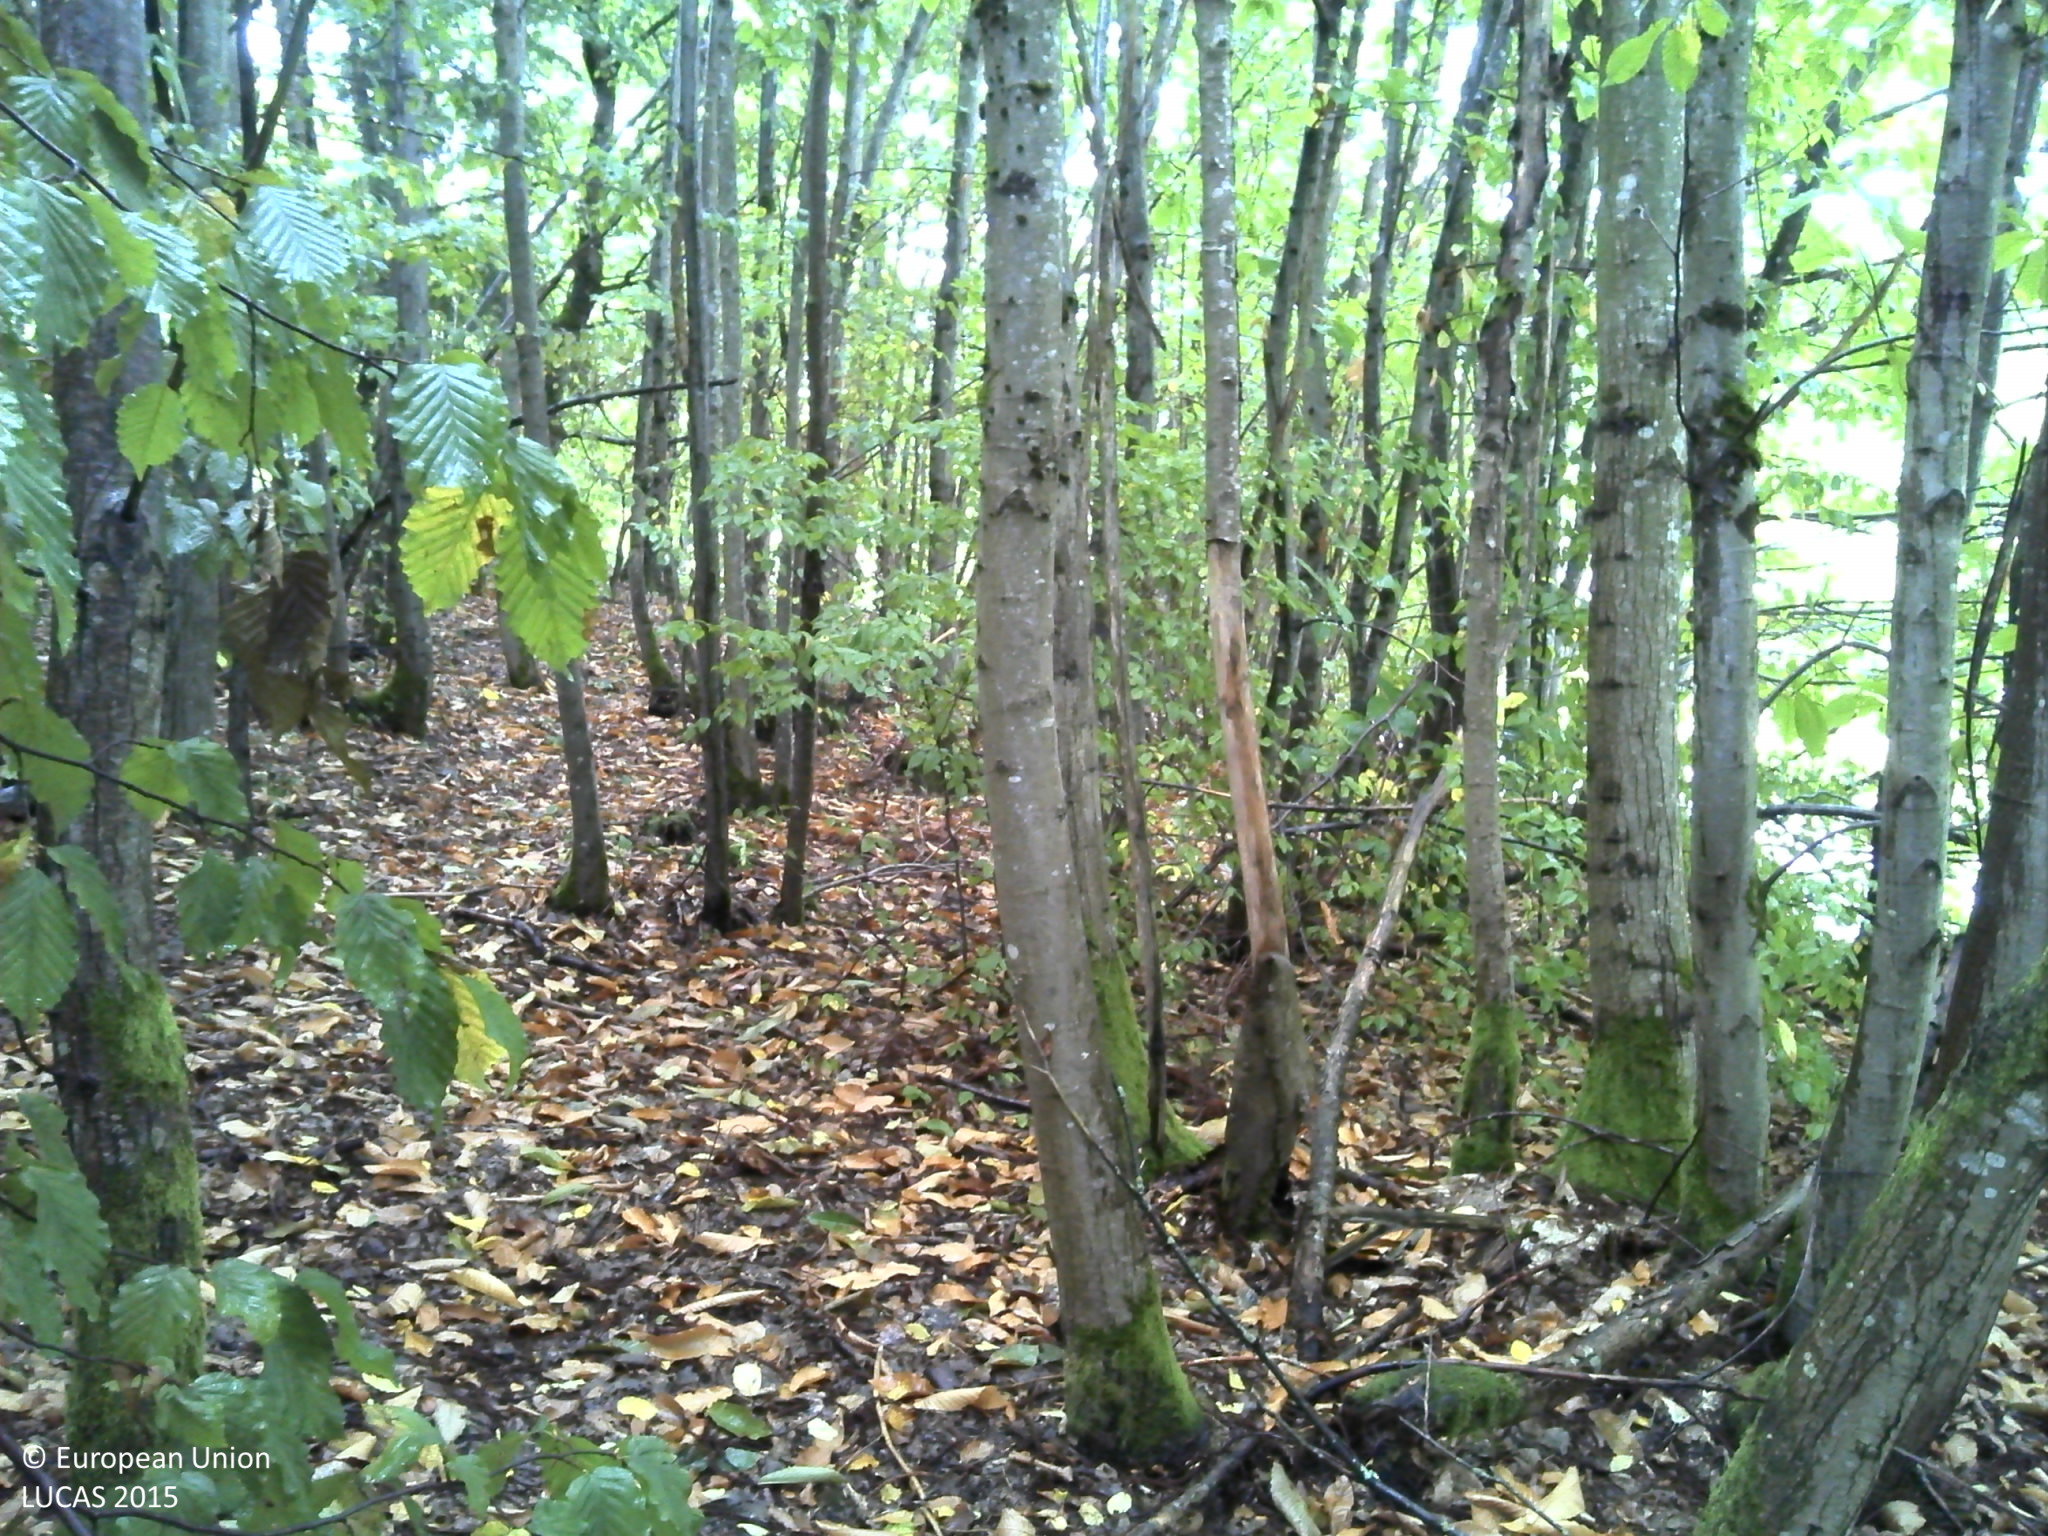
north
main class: Woodland
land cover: Broadleaved woodland
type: mesophytic deciduous forest
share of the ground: > 75 %
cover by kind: broadleaved forest trees 90 %, consolidated bare surface 10 %
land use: Forestry
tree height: > 5 m
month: September
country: FR
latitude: 48.3523
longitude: 7.2885
